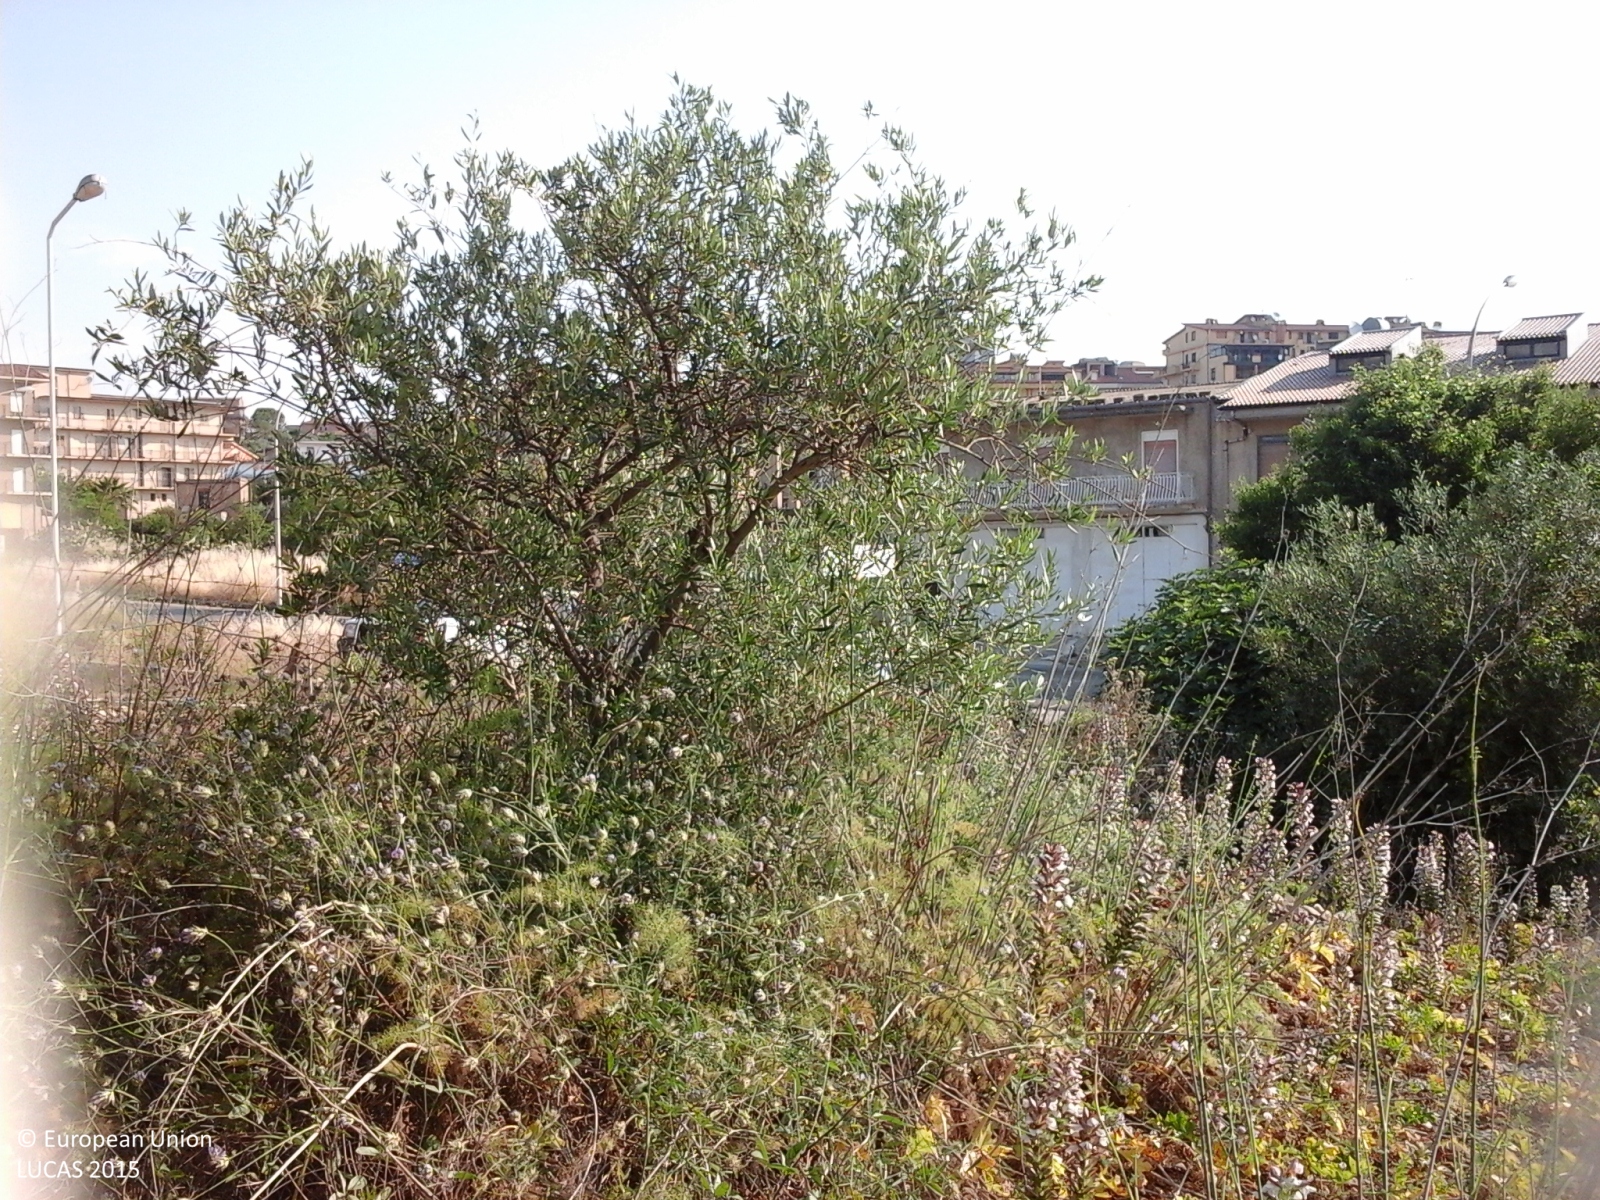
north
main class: Cropland
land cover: Olive groves
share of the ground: 25 - 50 %
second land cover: Spontaneously vegetated surfaces
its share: > 75 %
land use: Agriculture (excluding fallow land and kitchen gardens)
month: June
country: IT
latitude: 37.3912
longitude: 13.5307
